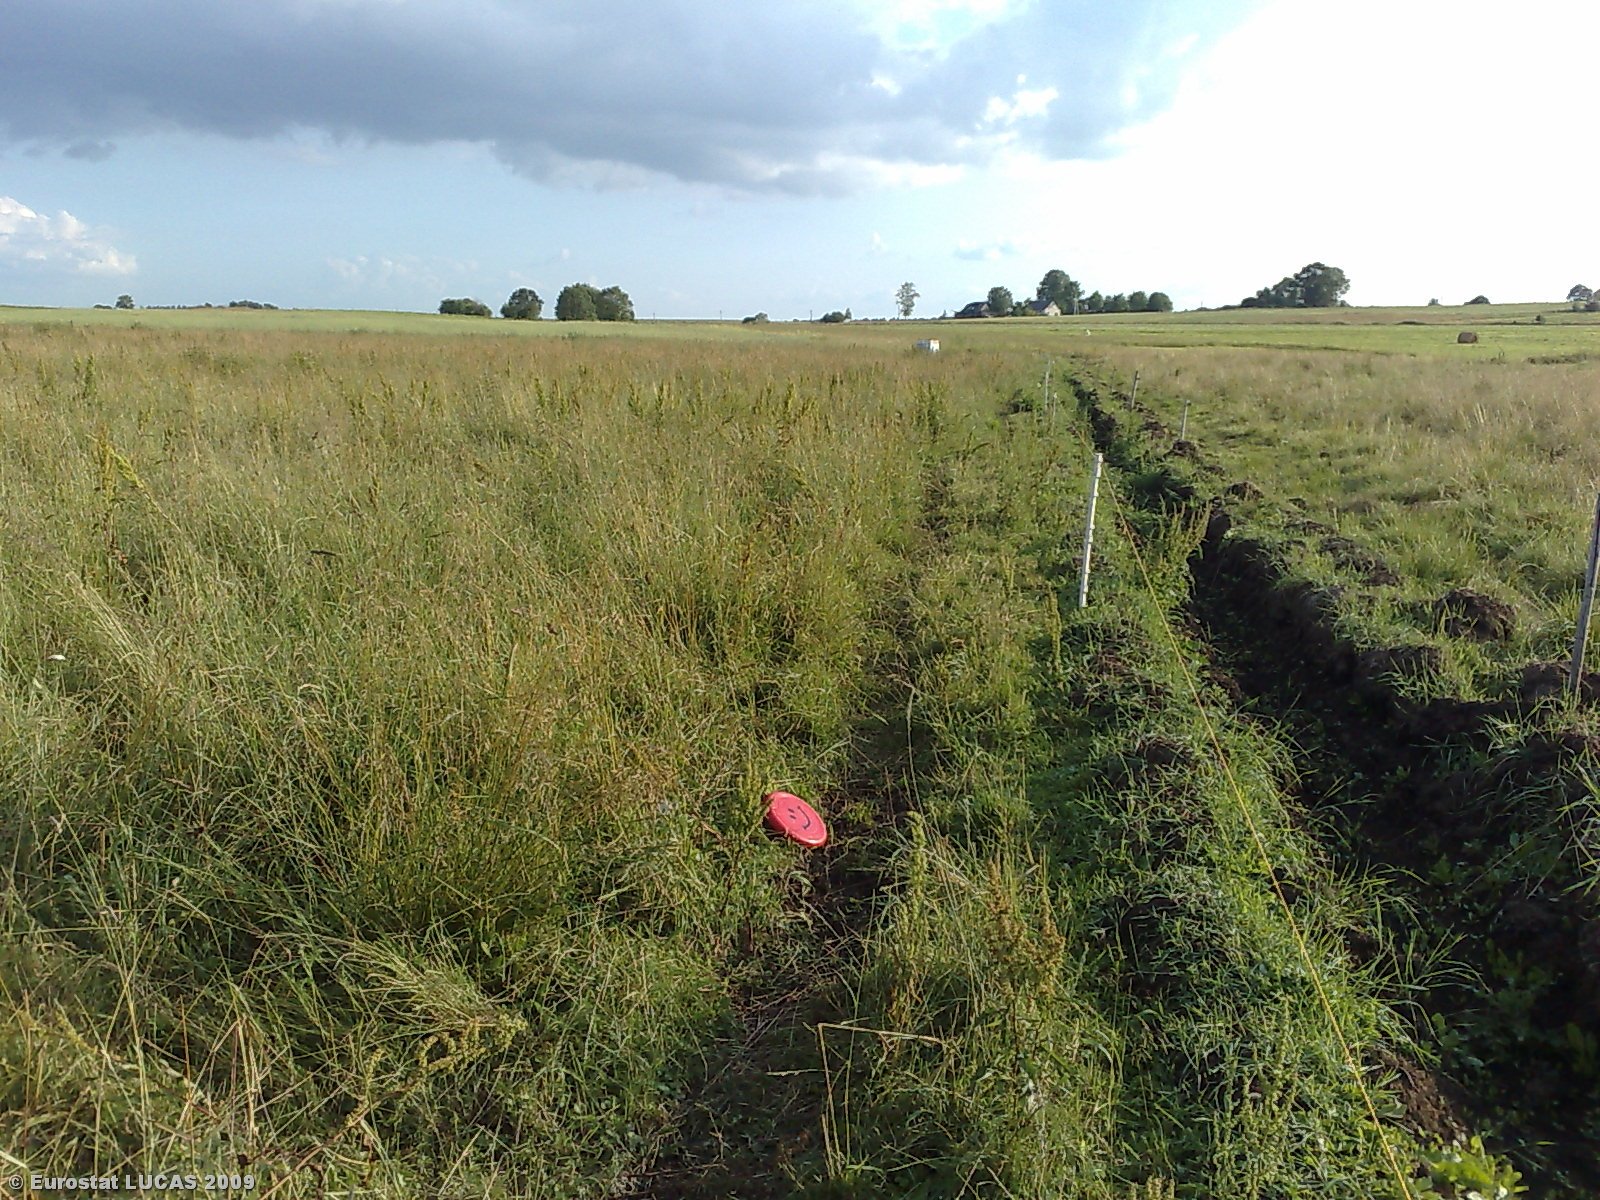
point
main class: Grassland
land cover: Grassland without tree/shrub cover
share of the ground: > 75 %
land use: Agriculture (excluding fallow land and kitchen gardens)
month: July
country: LT
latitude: 55.7767
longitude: 22.8360
